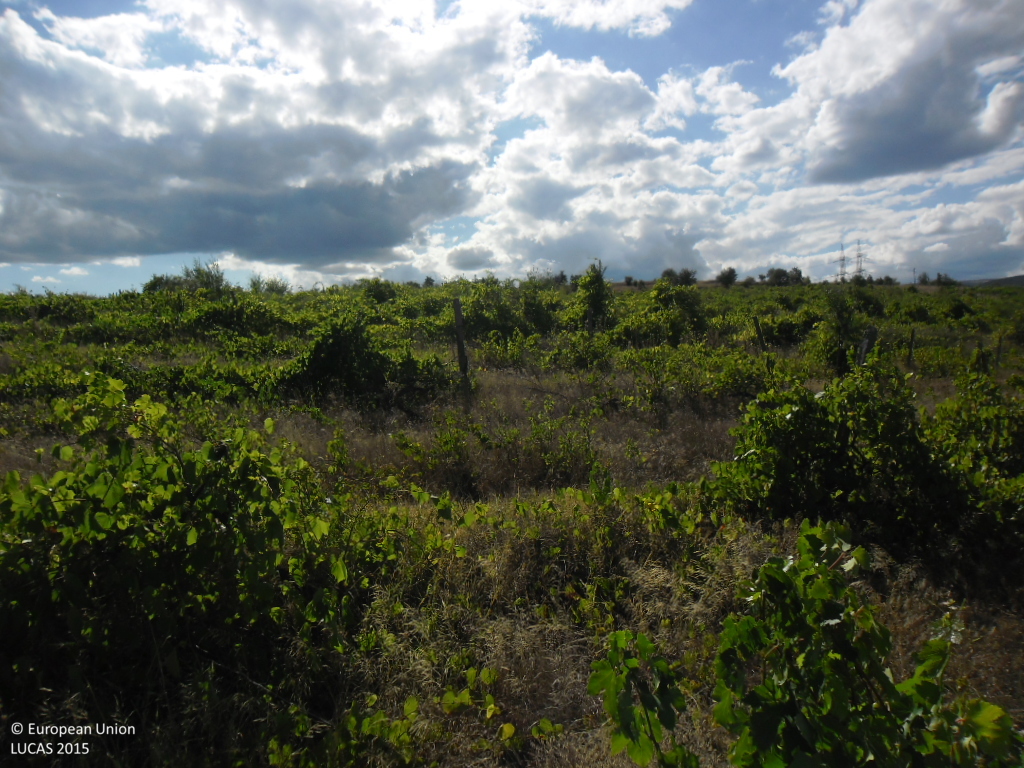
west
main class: Cropland
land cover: Vineyards
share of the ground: 50 - 75 %
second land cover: Spontaneously vegetated surfaces
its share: > 75 %
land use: Agriculture (excluding fallow land and kitchen gardens)
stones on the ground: < 10 %
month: August
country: BG
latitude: 42.0483
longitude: 23.0115
